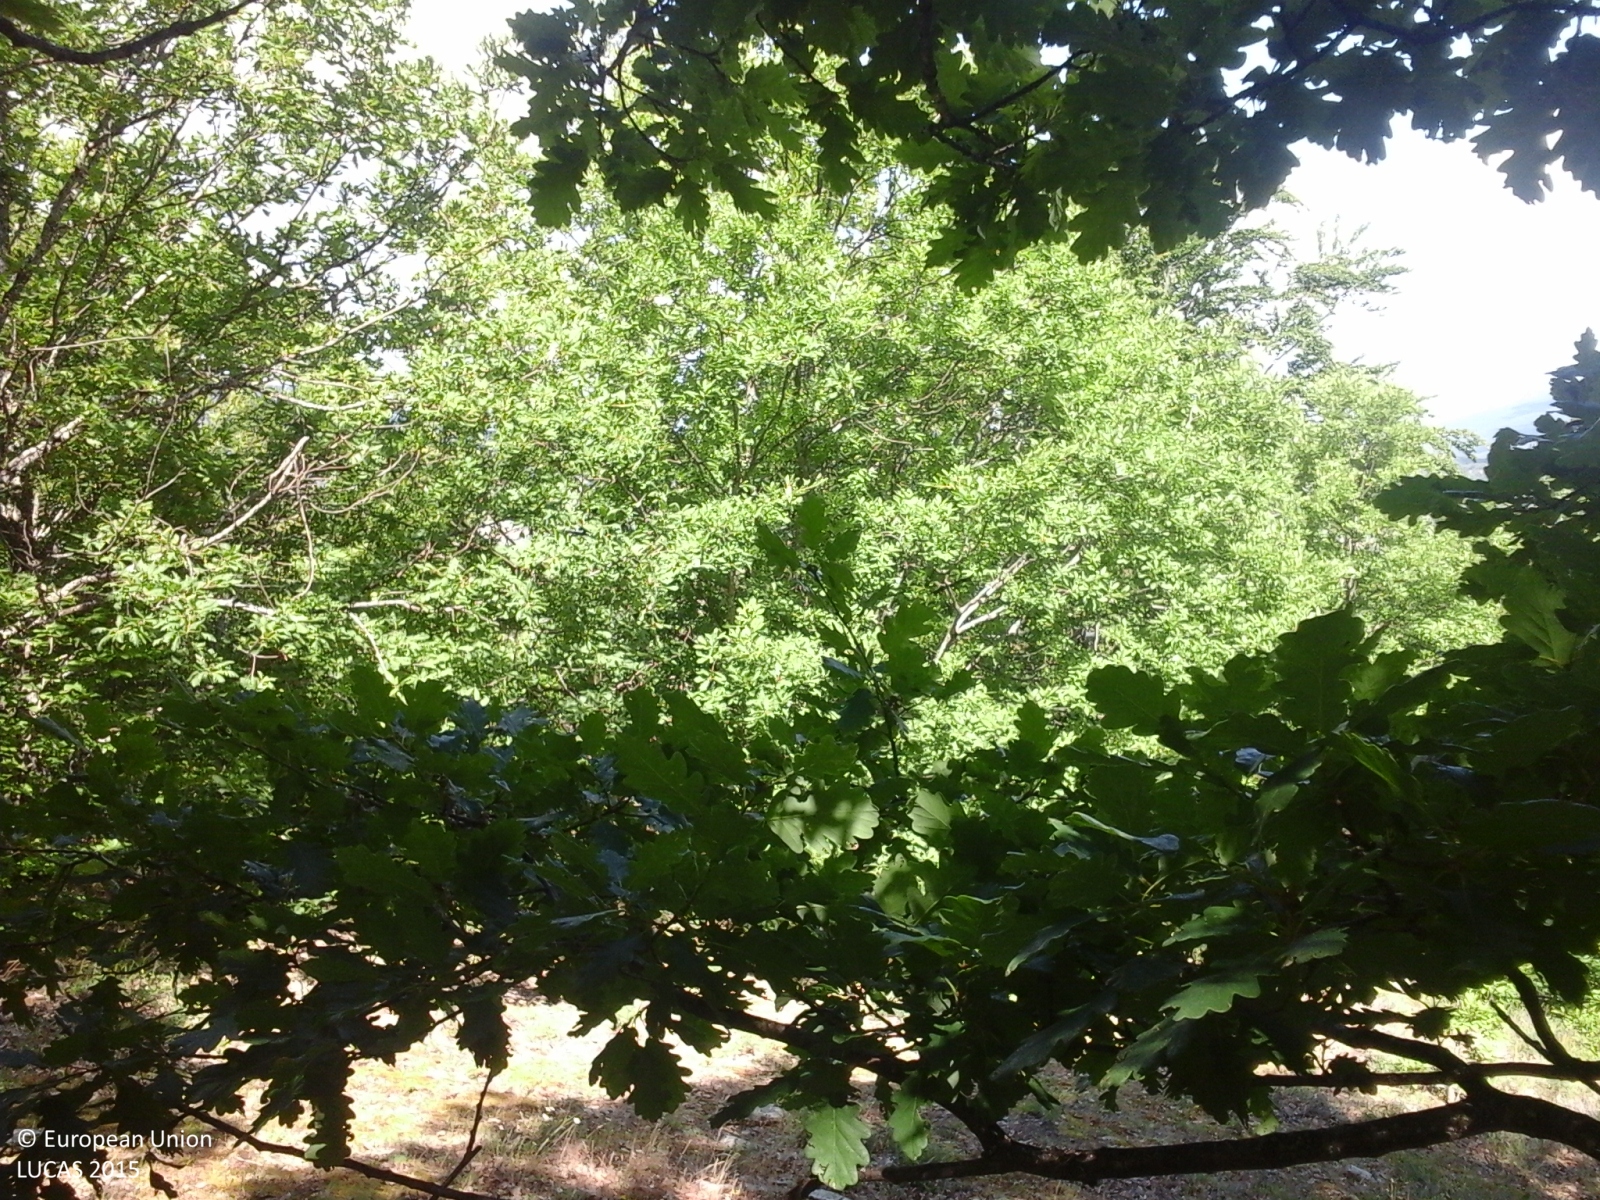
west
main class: Woodland
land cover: Broadleaved woodland
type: thermophilous deciduous forest
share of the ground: > 75 %
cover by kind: broadleaved forest trees 75 %, herbaceous plants 20 %, lichens and mosses 5 %
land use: Forestry
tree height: > 5 m
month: June
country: GR
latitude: 40.6129
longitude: 21.3264
